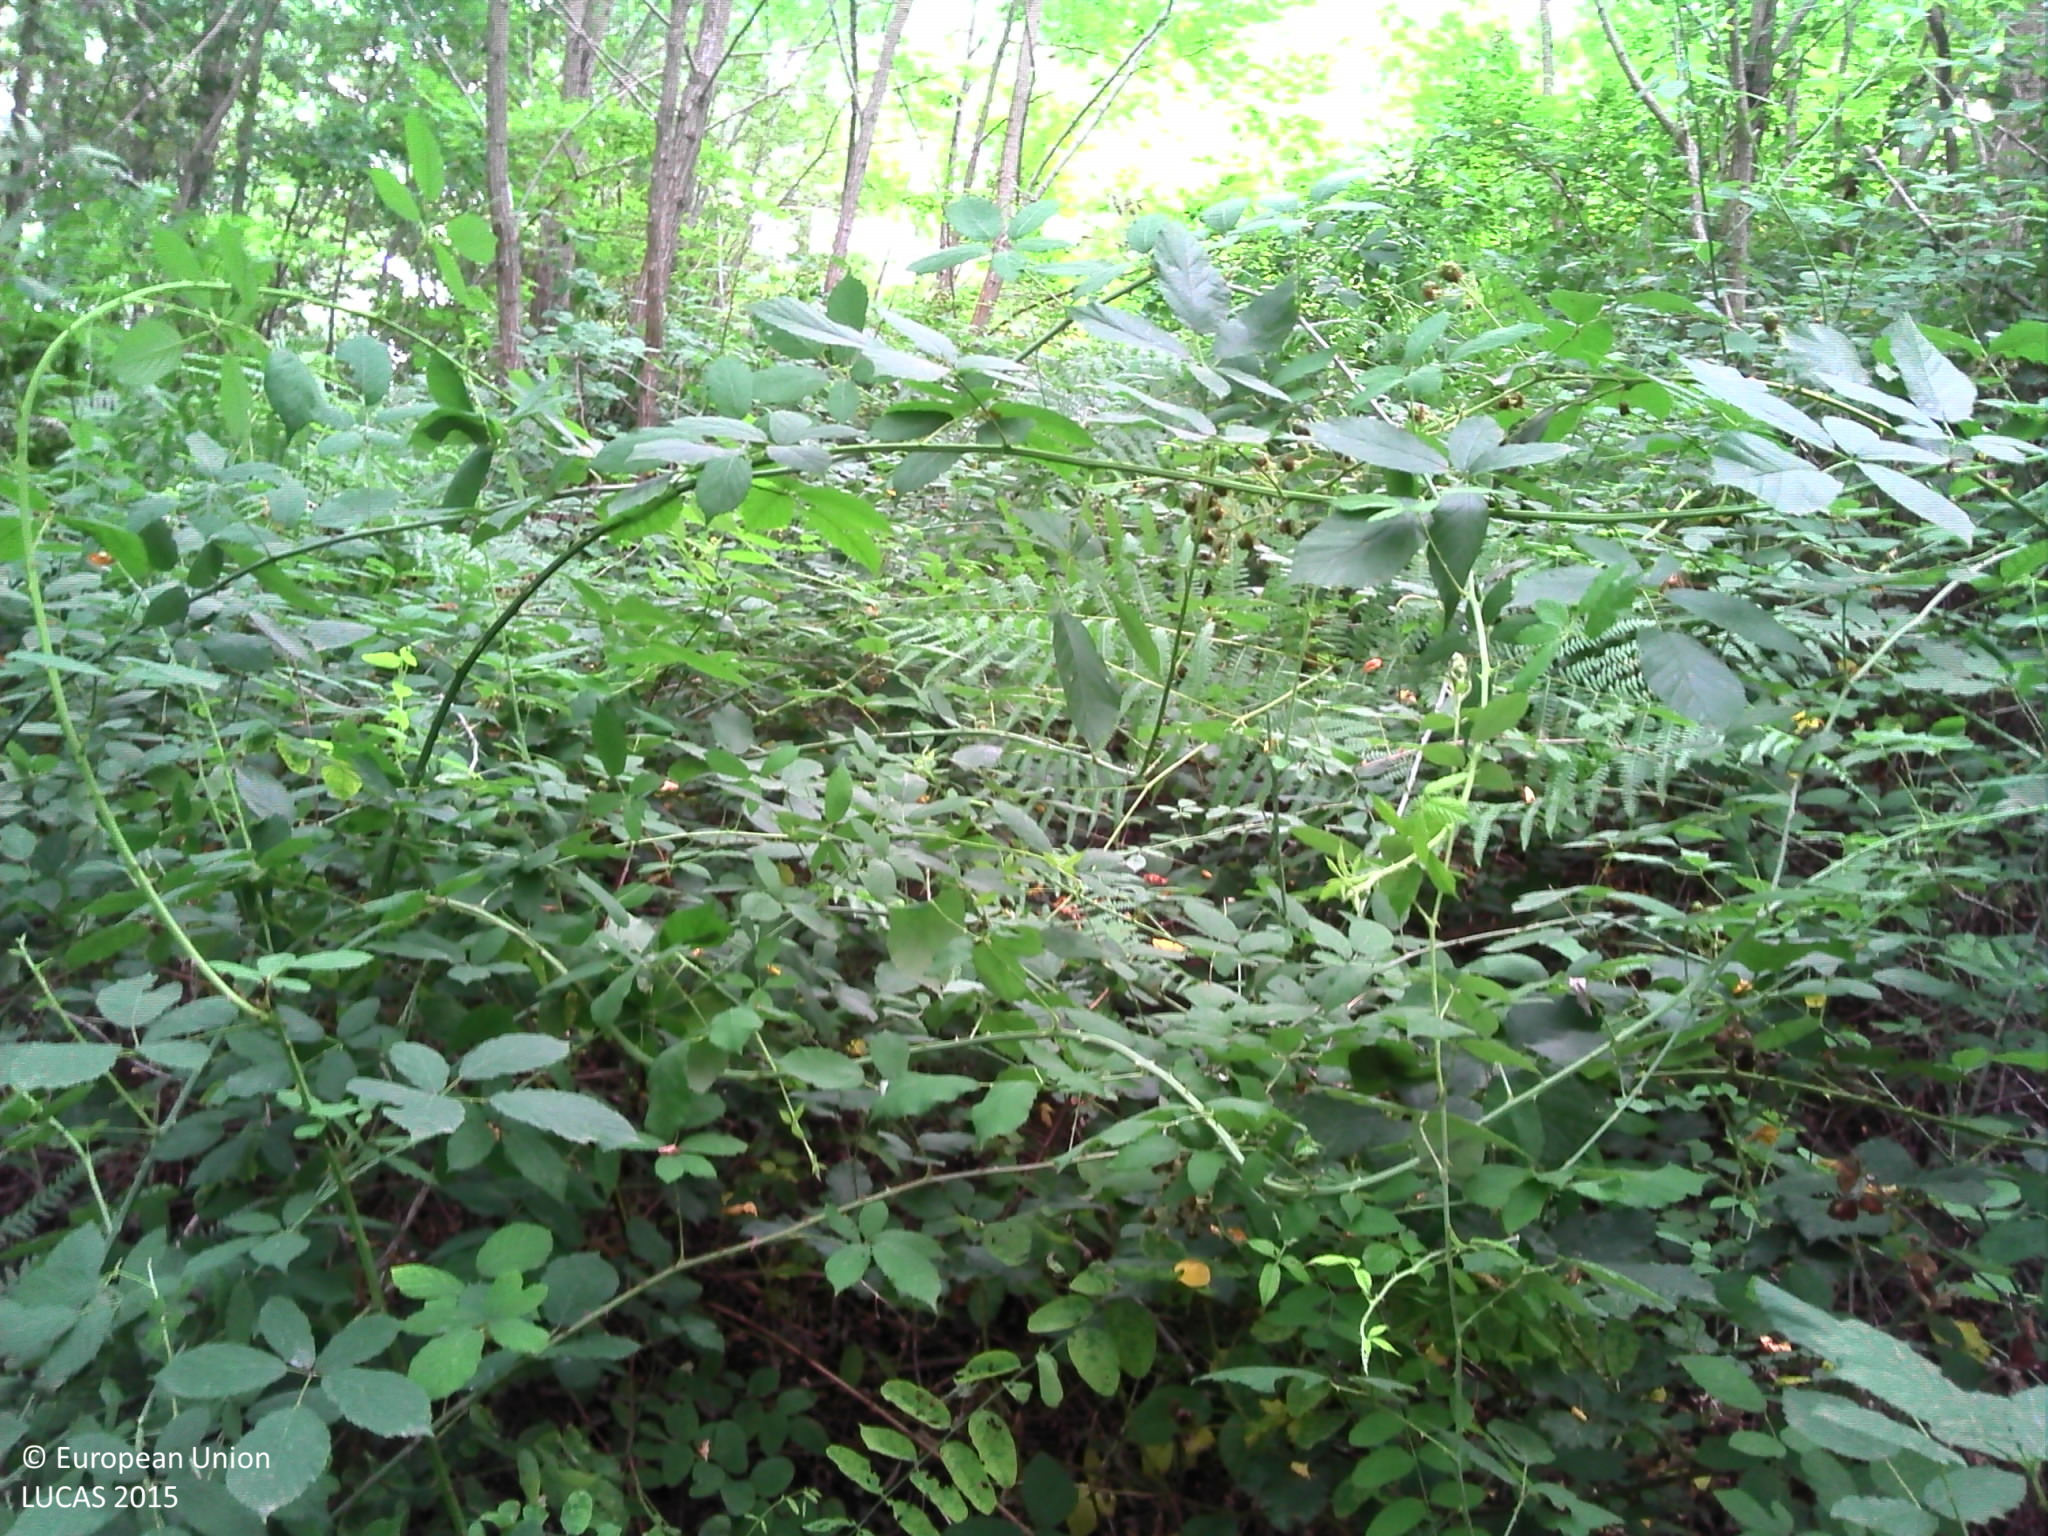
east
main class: Woodland
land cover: Pine dominated mixed woodland
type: coniferous forest of the mediterranean region
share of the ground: > 75 %
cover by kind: coniferous forest trees 30 %, broadleaved forest trees 30 %, shrubs 20 %, herbaceous plants 20 %
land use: Forestry
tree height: > 5 m
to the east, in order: Pine dominated coniferous woodland; Tracks; Grassland with sparse tree/shrub cover; Broadleaved woodland; Tracks; Managed hedges; Tracks; Managed hedges; Lines of trees; Grass margins; Paved roads, cycling and walking lanes; Grass margins; Grassland with sparse tree/shrub cover; Broadleaved woodland; Ditches and canals; Grass margins; Durum wheat
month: July
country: FR
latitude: 44.9703
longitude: 0.5439
